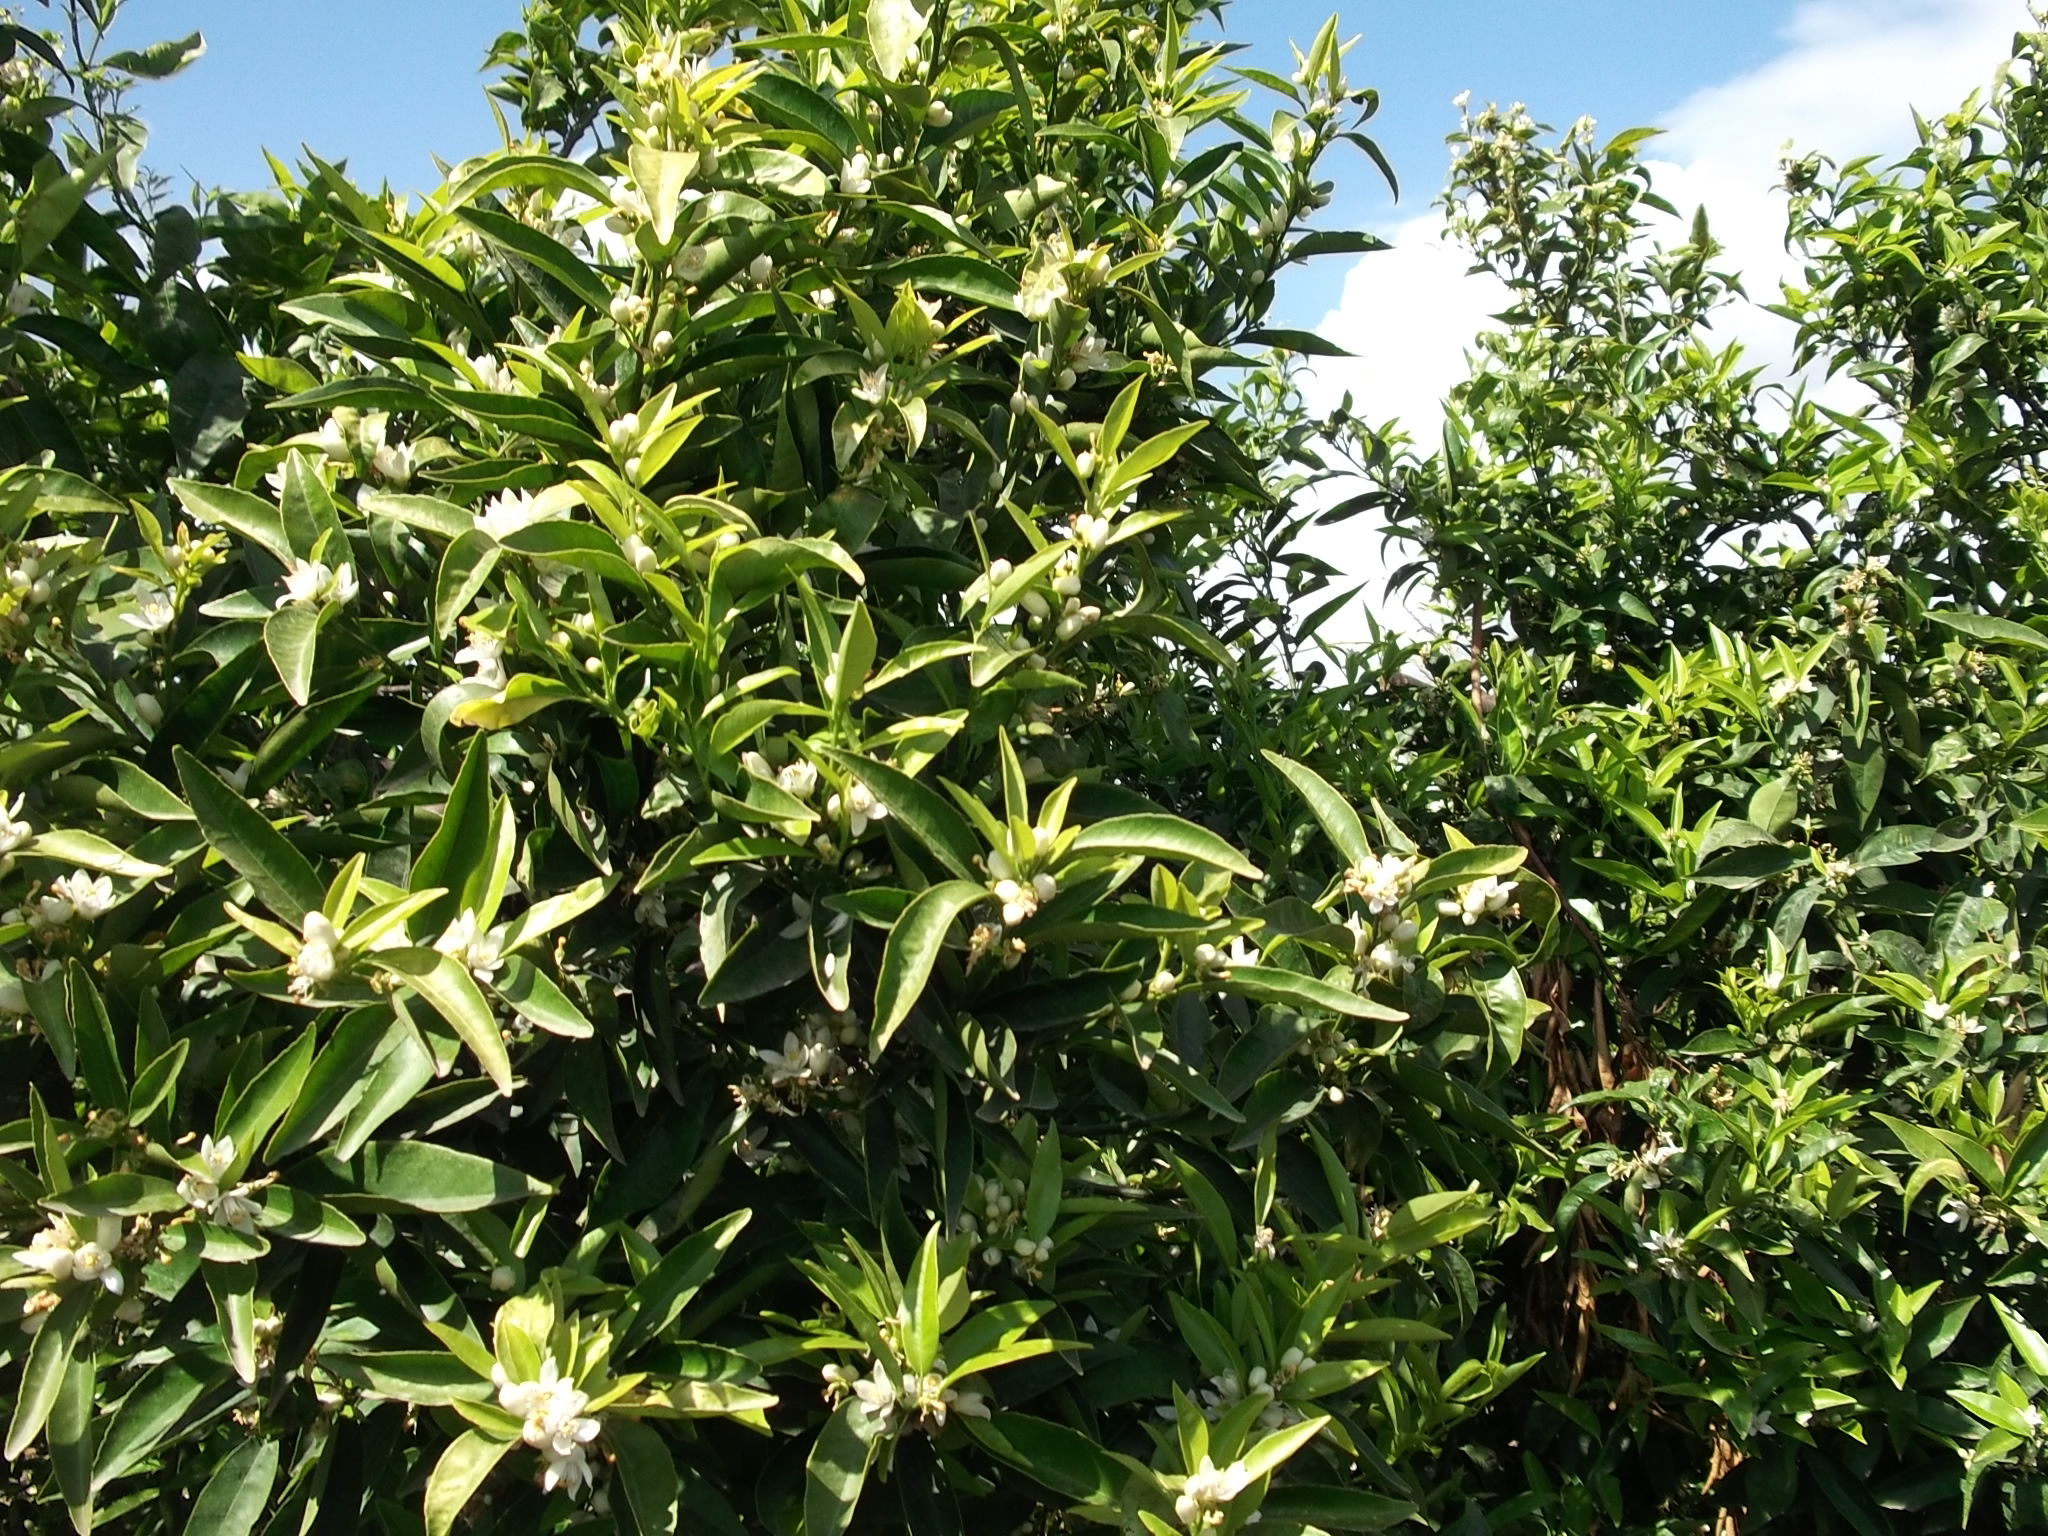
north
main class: Cropland
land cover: Oranges
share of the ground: 50 - 75 %
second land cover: Other bare soil
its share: > 75 %
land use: Agriculture (excluding fallow land and kitchen gardens)
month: April
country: ES
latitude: 38.1704
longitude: -0.9775
